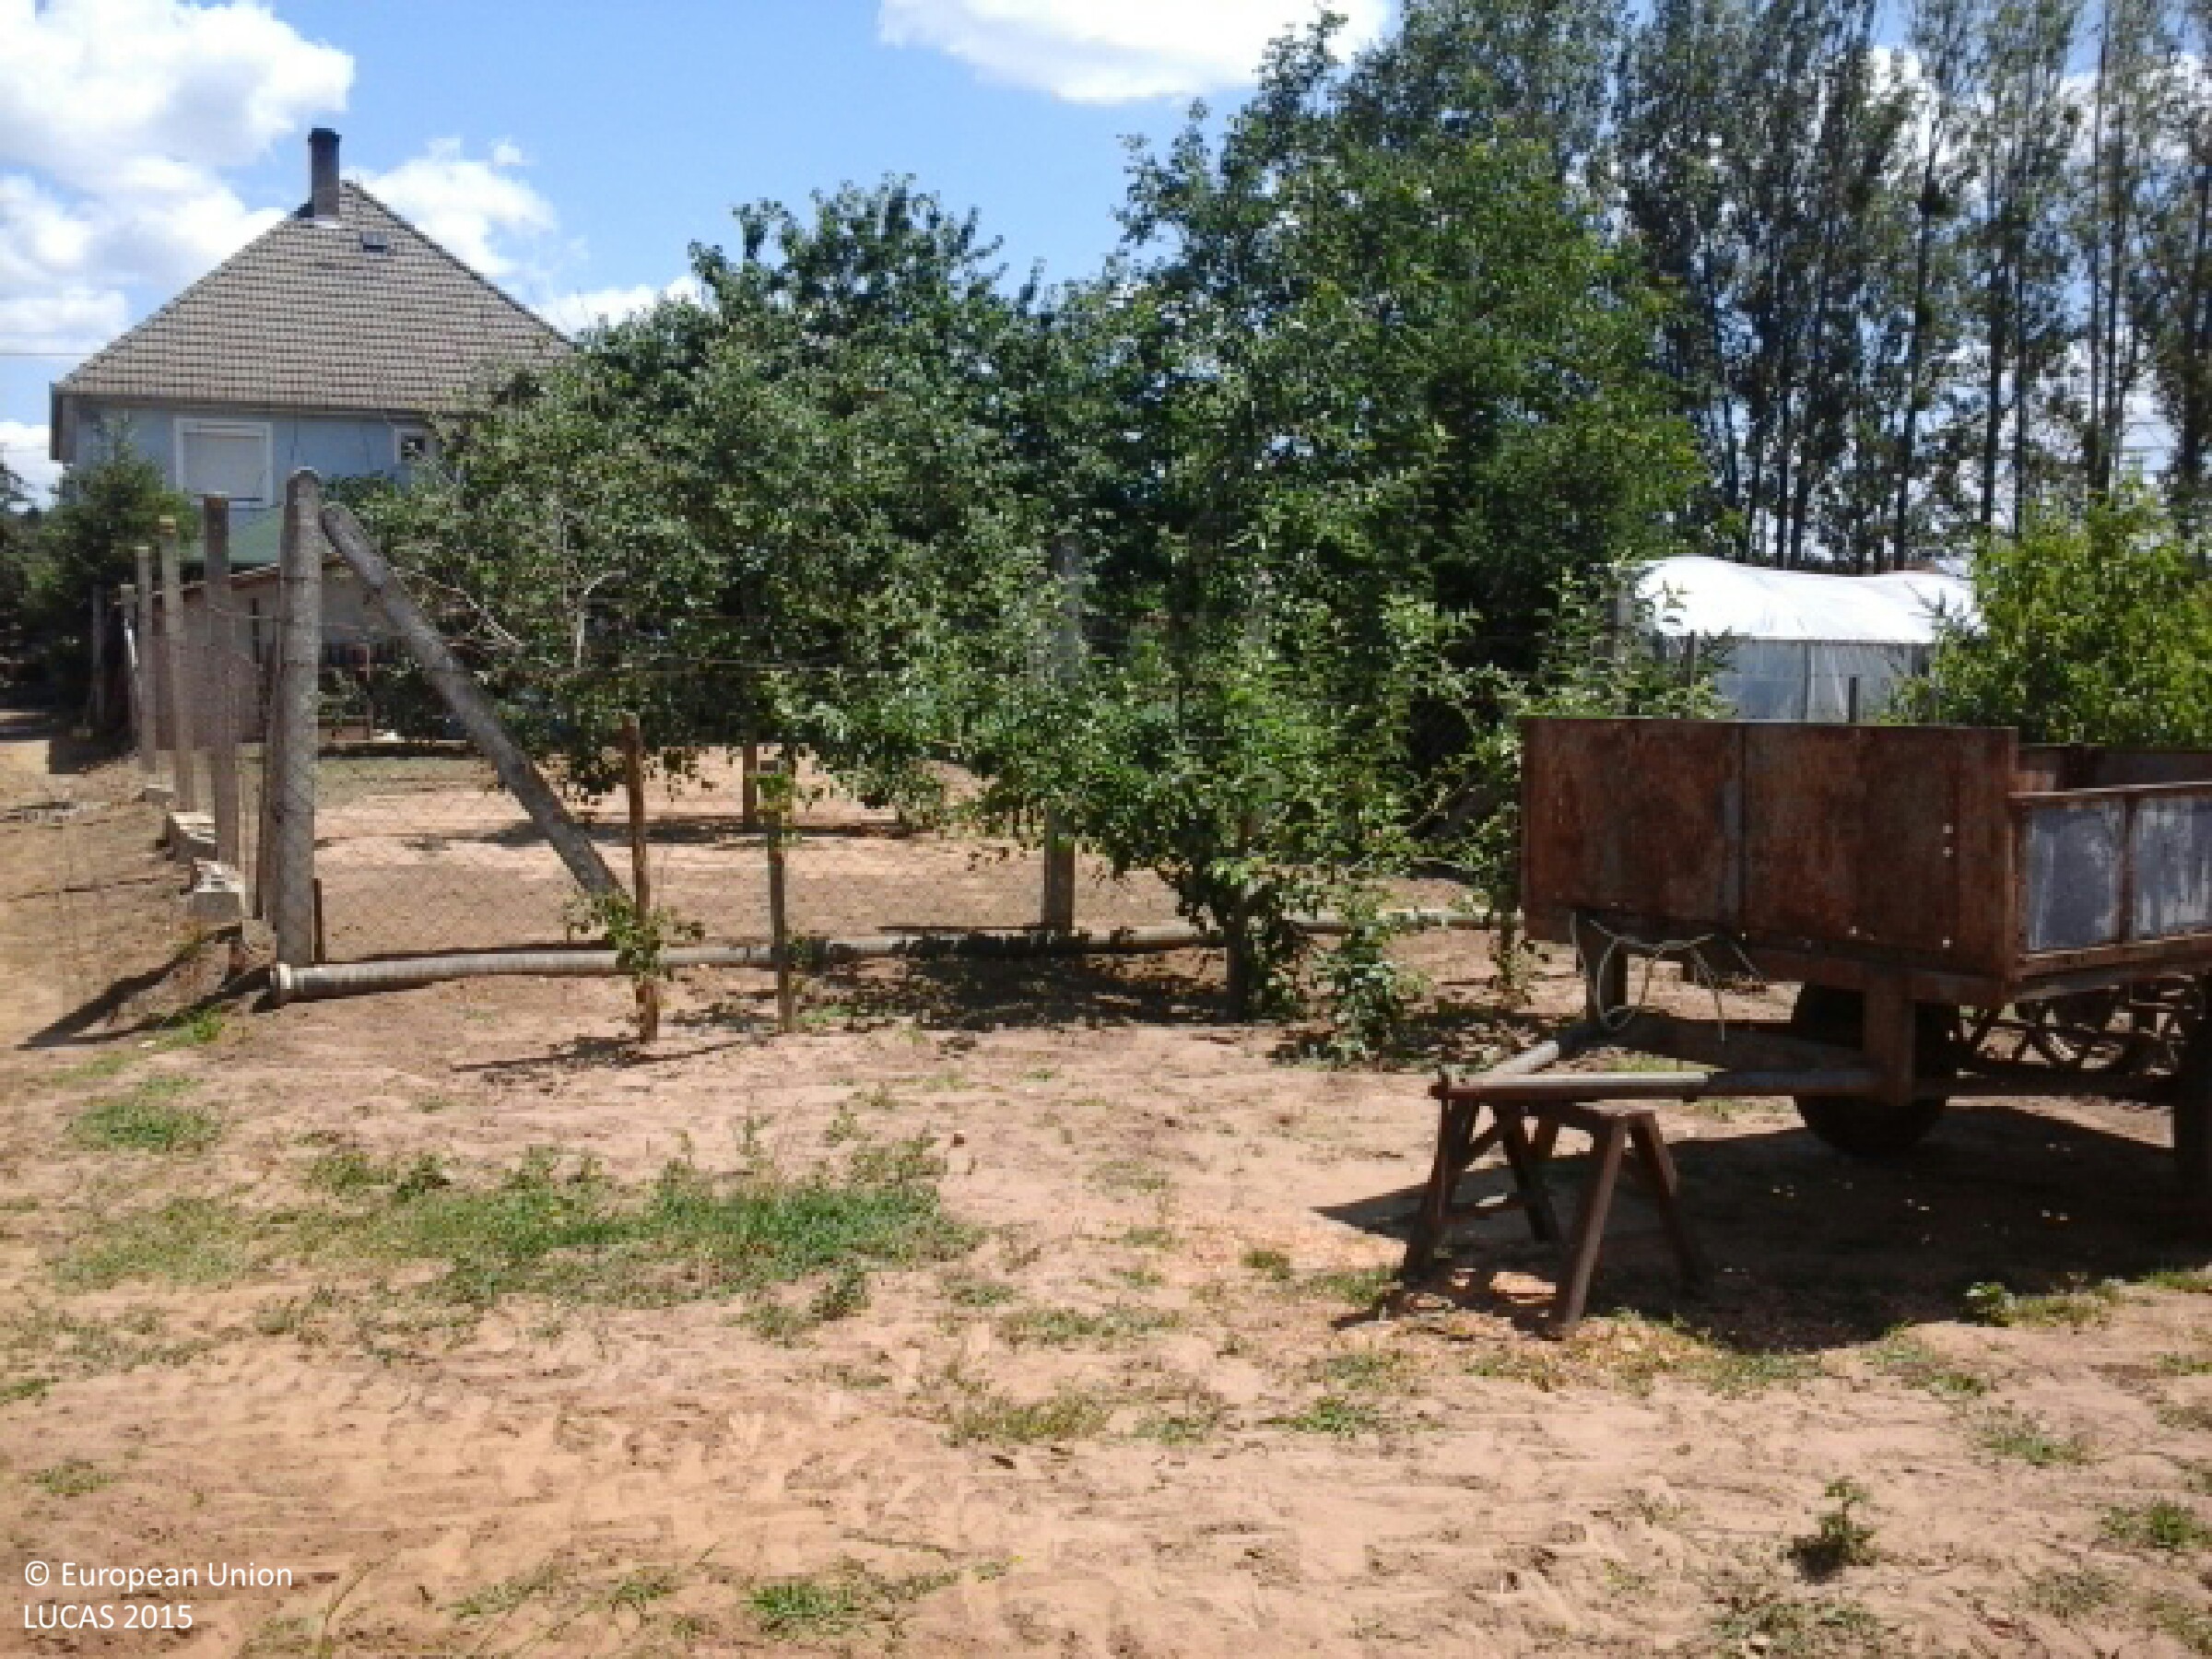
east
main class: Grassland
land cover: Spontaneously vegetated surfaces
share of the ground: > 75 %
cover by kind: unconsolidated bare surface 80 %, herbaceous plants 20 %
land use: Residential
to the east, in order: Spontaneously vegetated surfaces; Artificial constructions in urban areas; Cherry fruit; Lines of trees; Grassland without tree/shrub cover
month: July
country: HU
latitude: 48.2683
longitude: 22.0580
